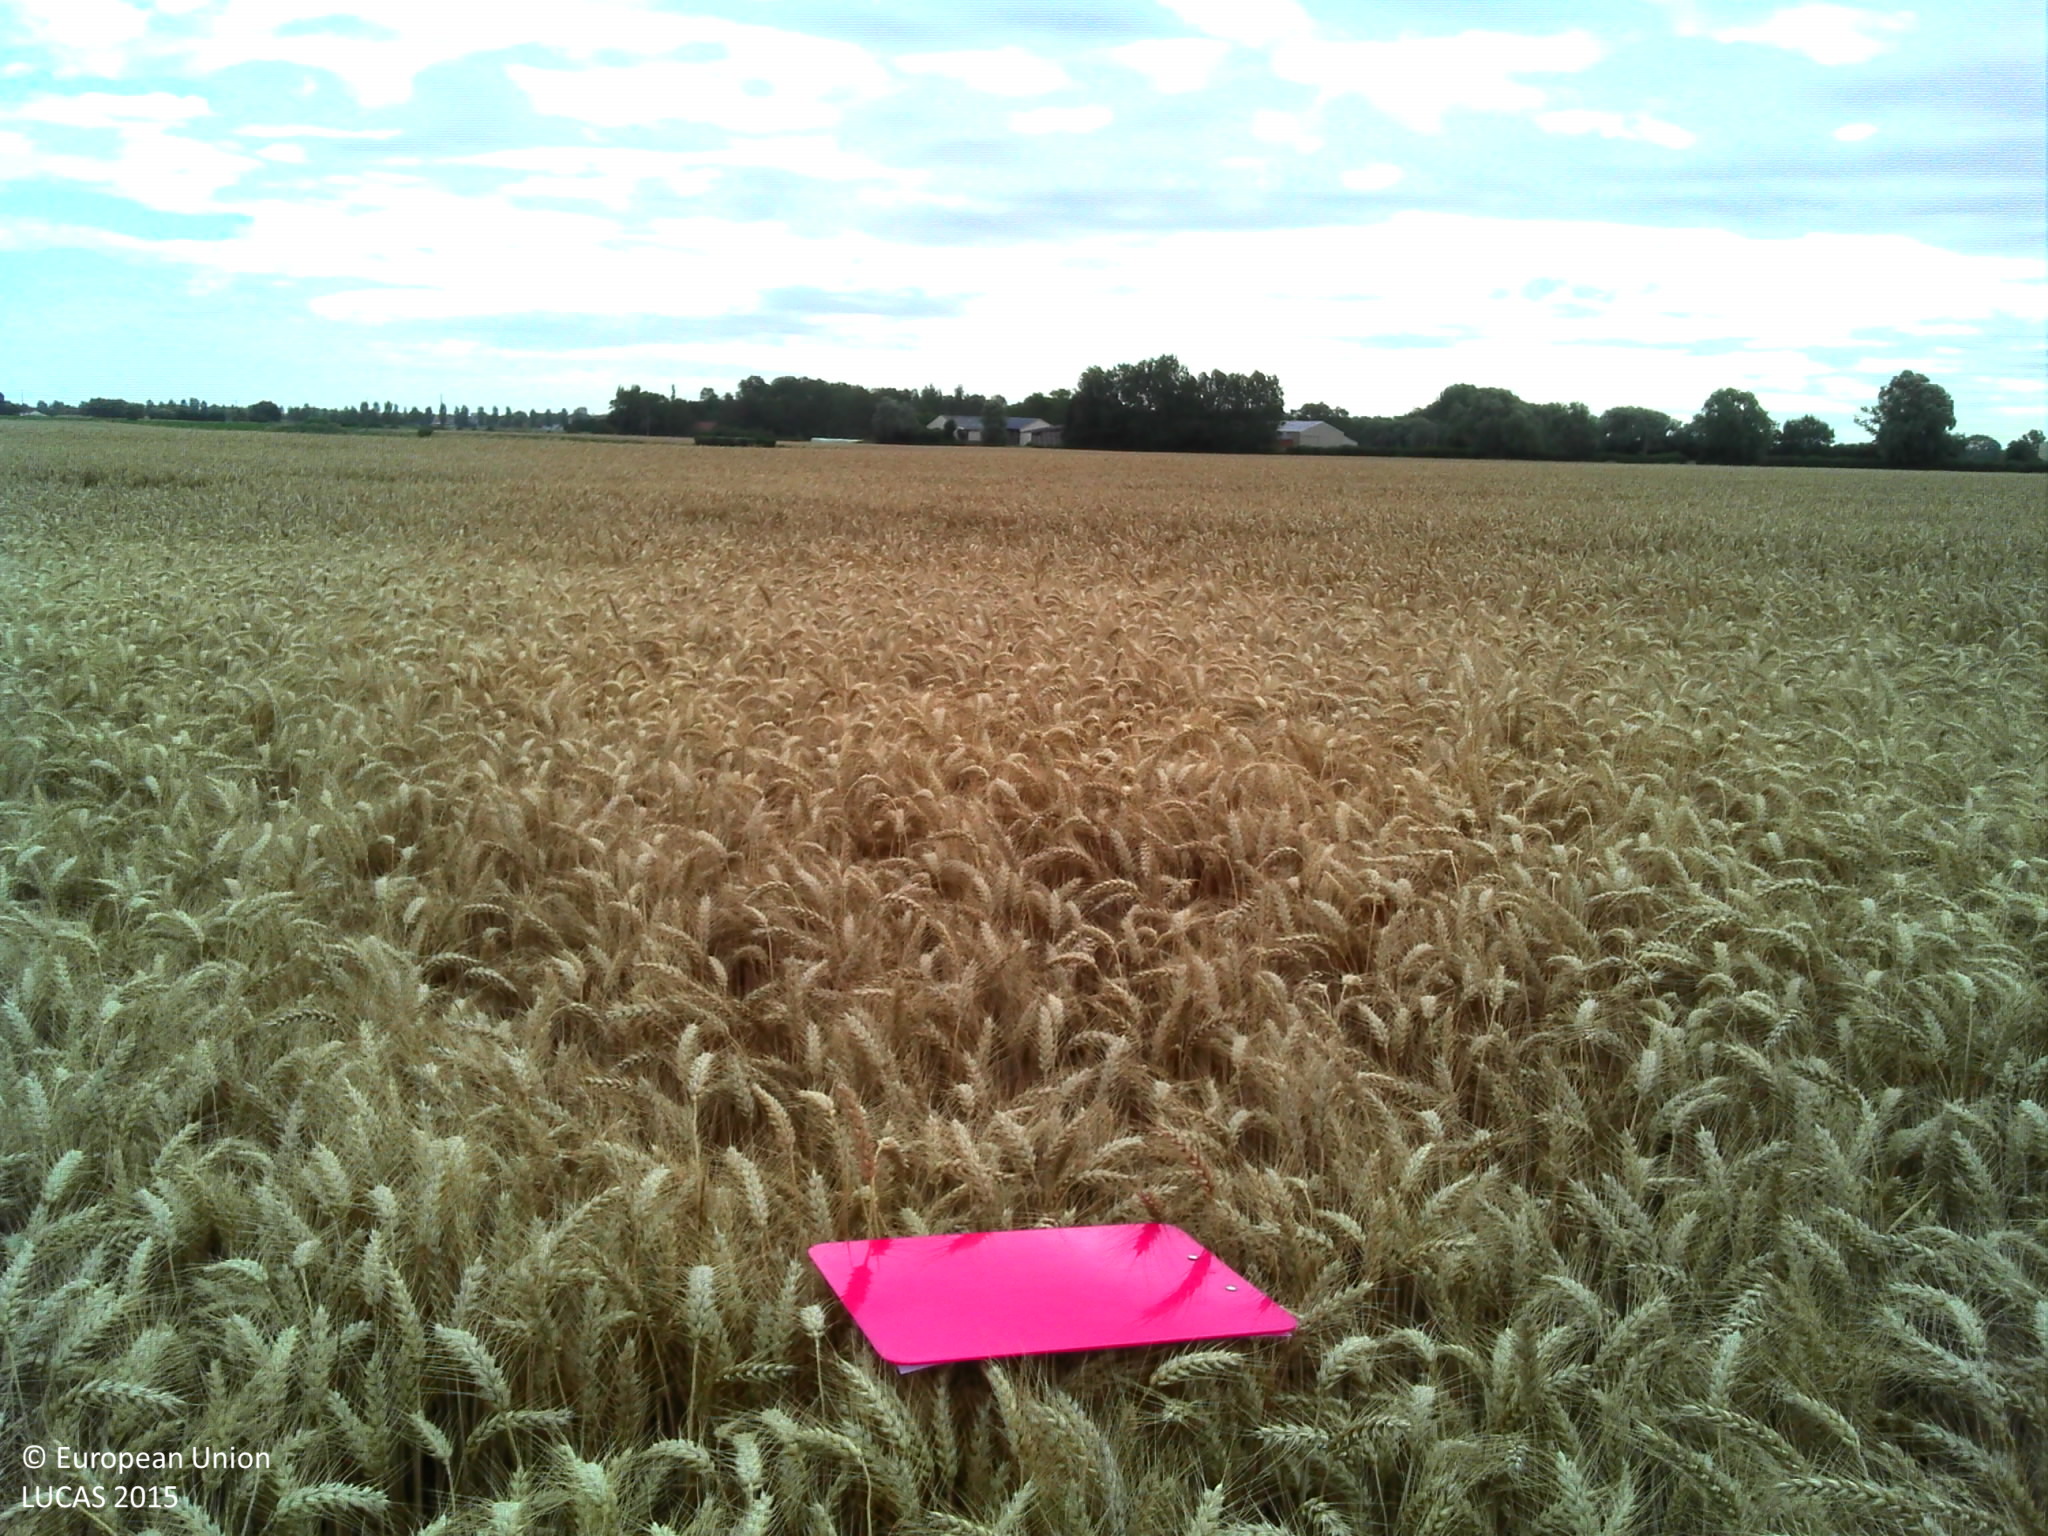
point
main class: Cropland
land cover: Common wheat
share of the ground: > 75 %
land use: Agriculture (excluding fallow land and kitchen gardens)
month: July
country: FR
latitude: 50.9165
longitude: 2.2907
